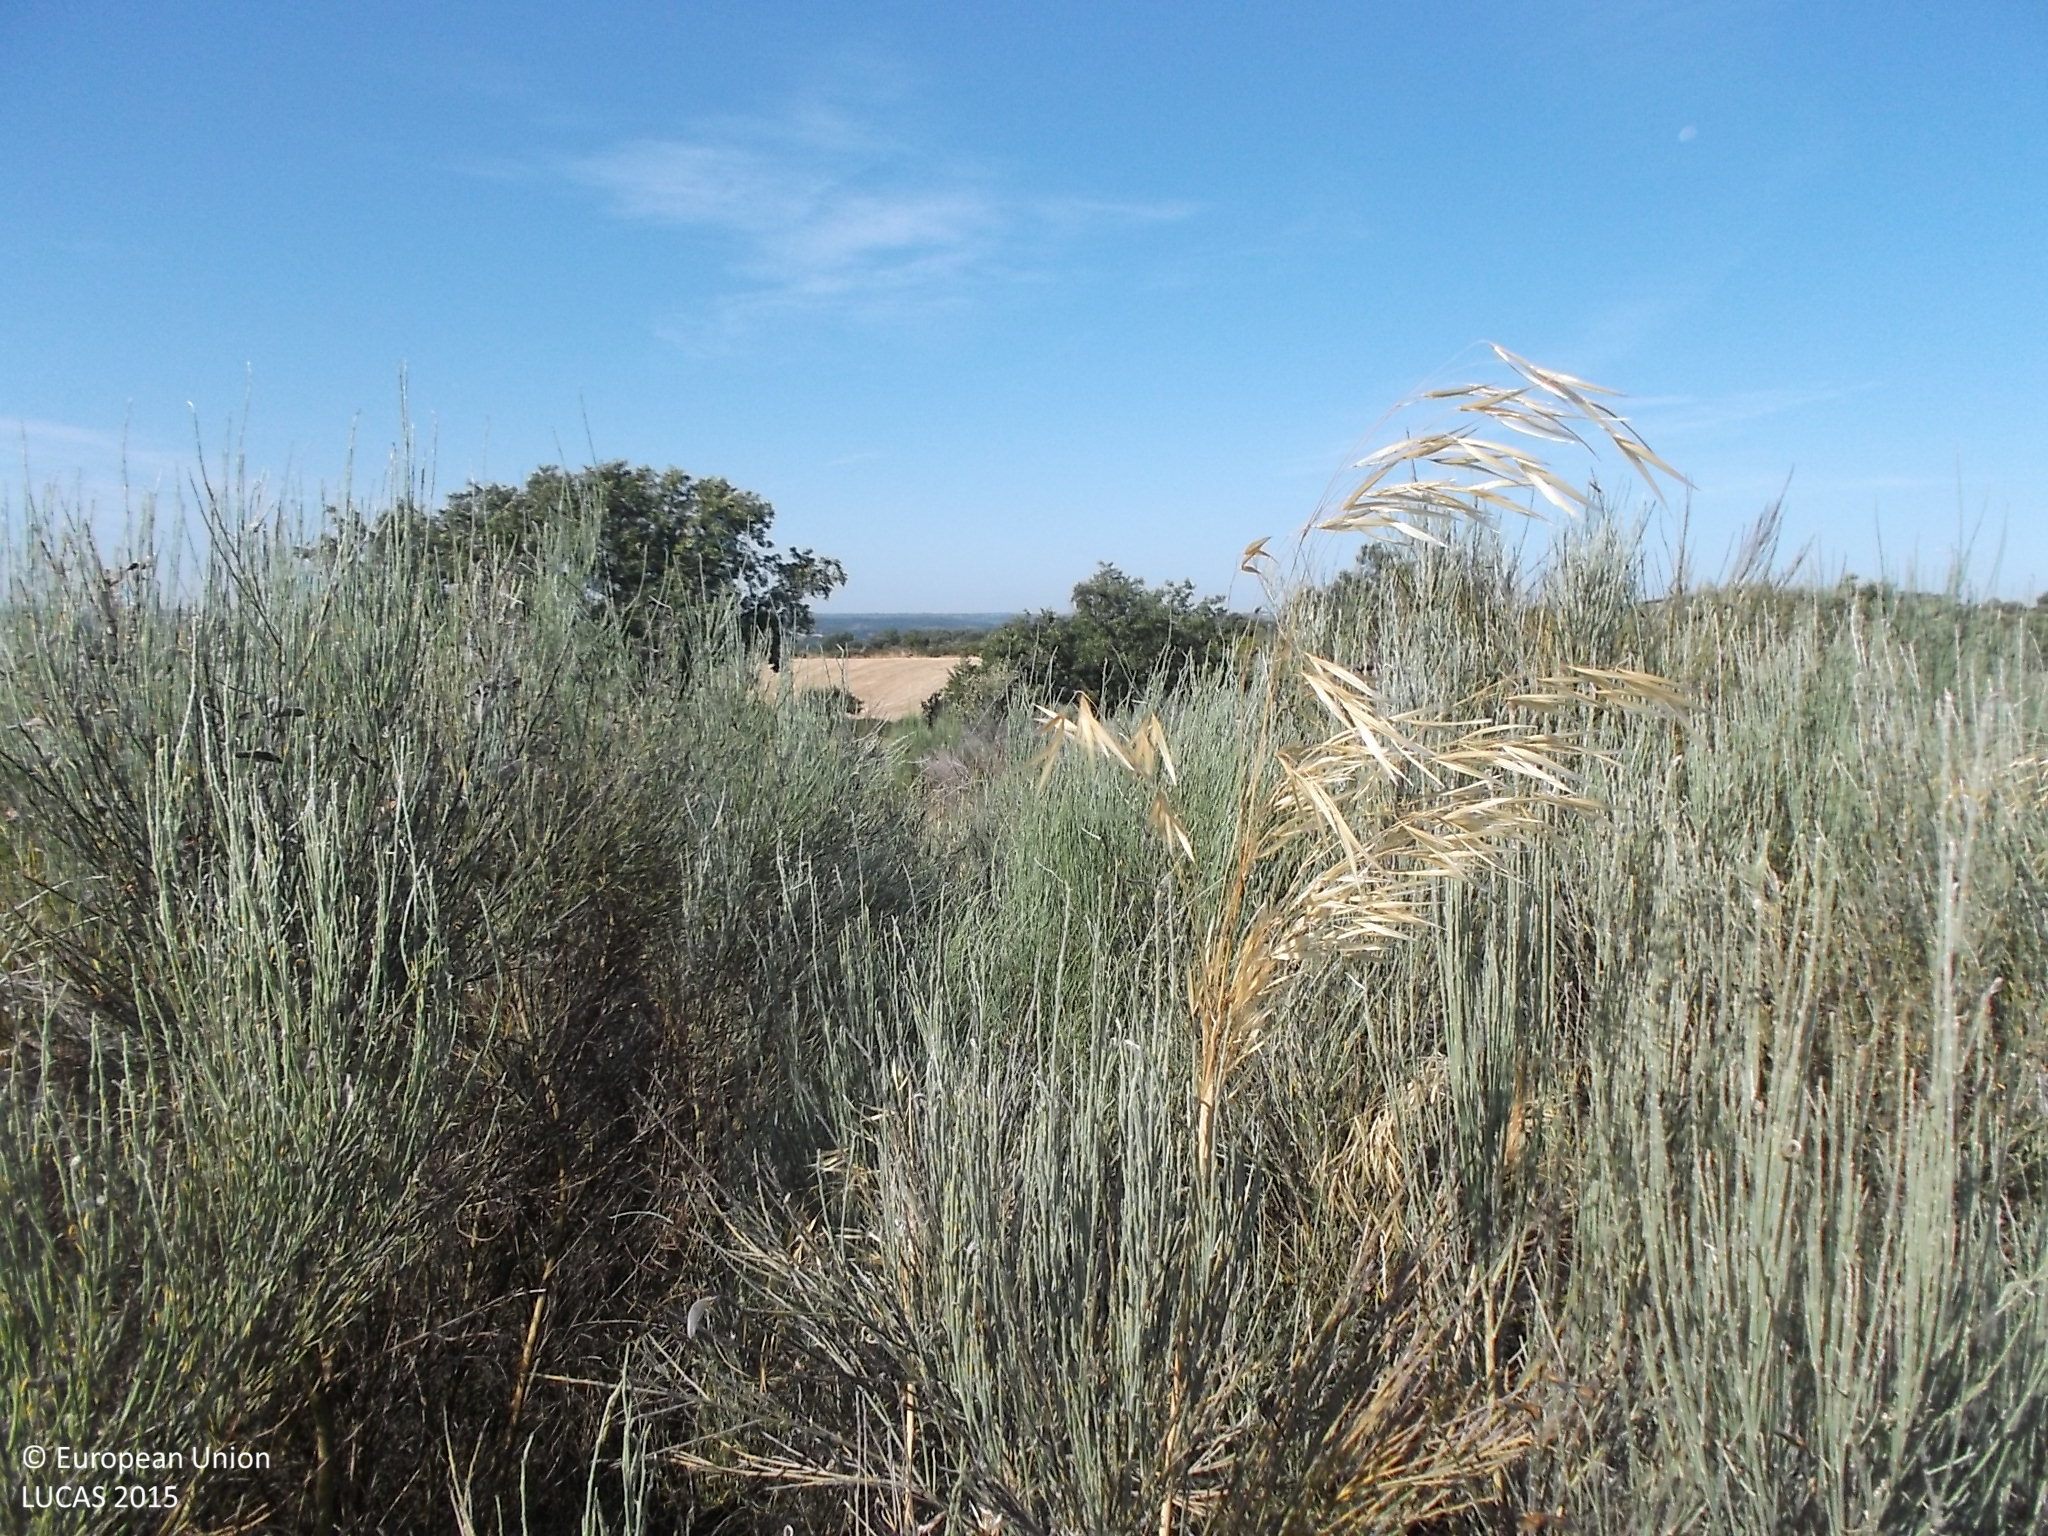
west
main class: Shrubland
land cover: Shrubland without tree cover
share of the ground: > 75 %
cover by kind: shrubs 100 %
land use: Semi-natural and natural areas not in use
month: July
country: ES
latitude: 41.2125
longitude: -6.5223
